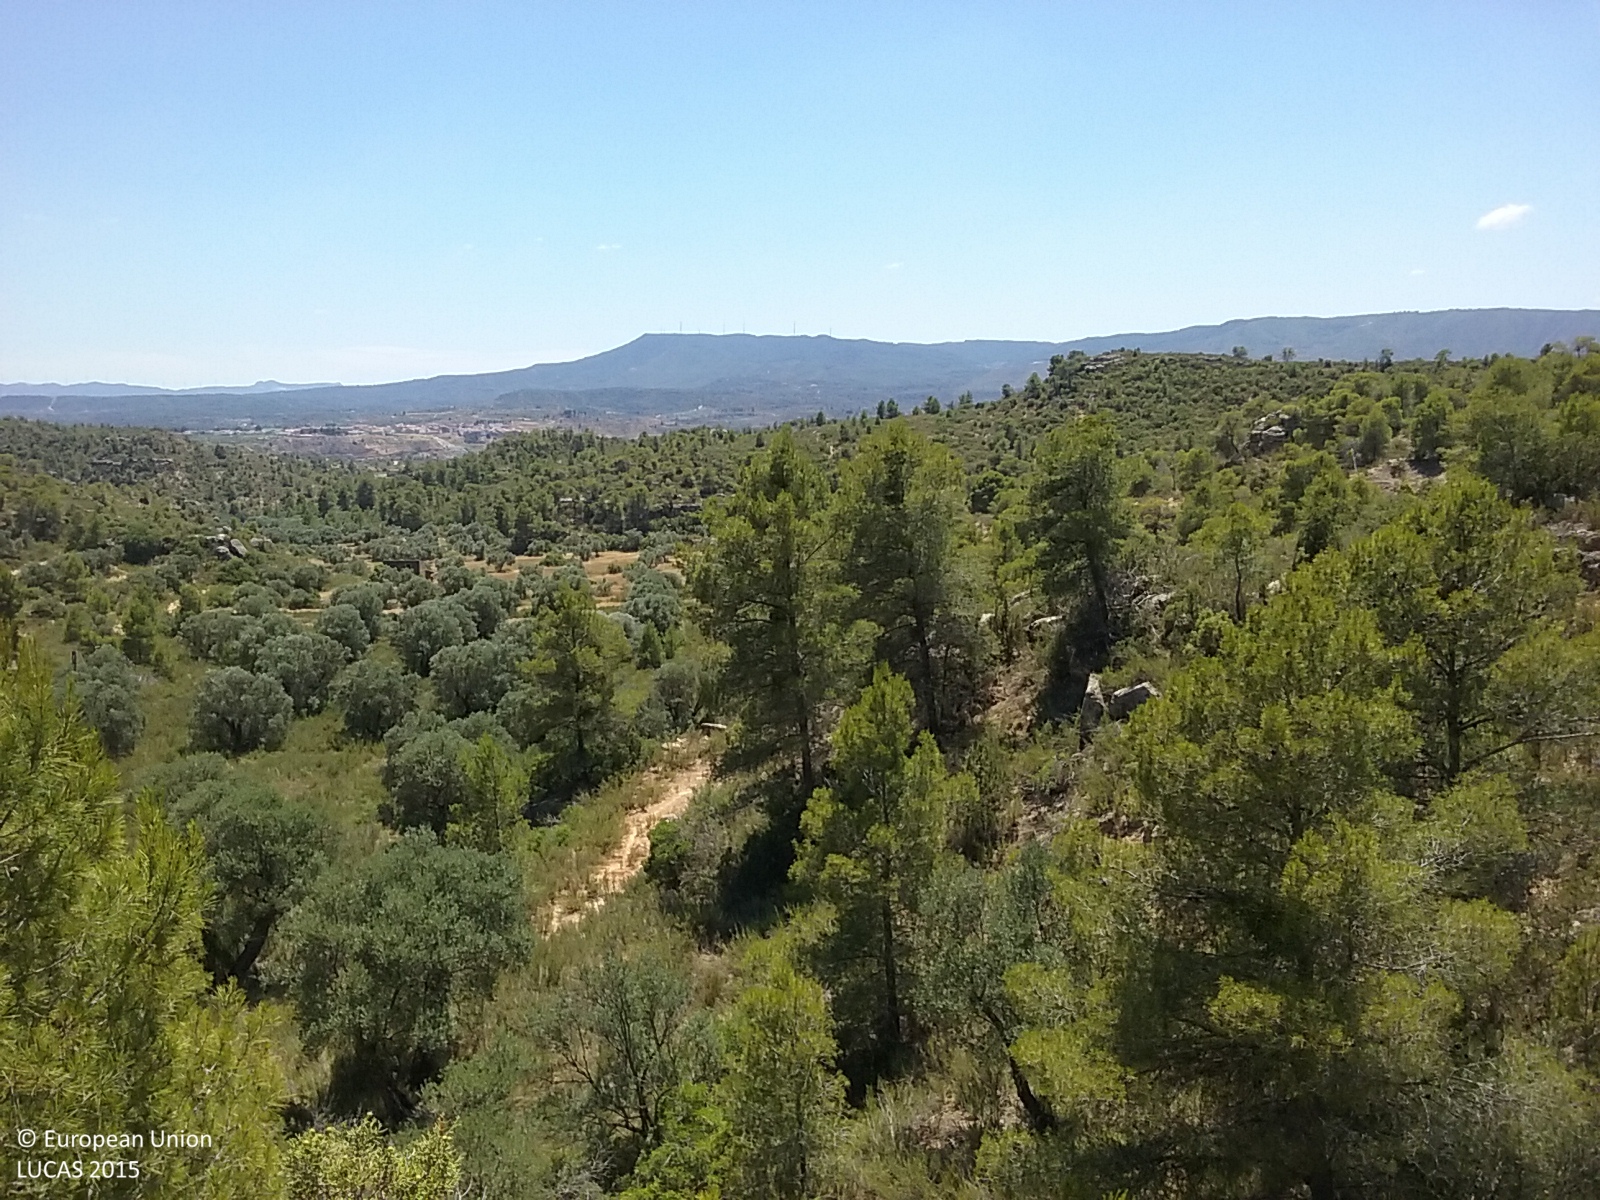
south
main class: Woodland
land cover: Pine dominated coniferous woodland
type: coniferous forest of the mediterranean region
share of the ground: 25 - 50 %
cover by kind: coniferous forest trees 40 %, shrubs 40 %, herbaceous plants 20 %
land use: Semi-natural and natural areas not in use
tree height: > 5 m
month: June
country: ES
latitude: 41.2770
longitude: 0.4747
